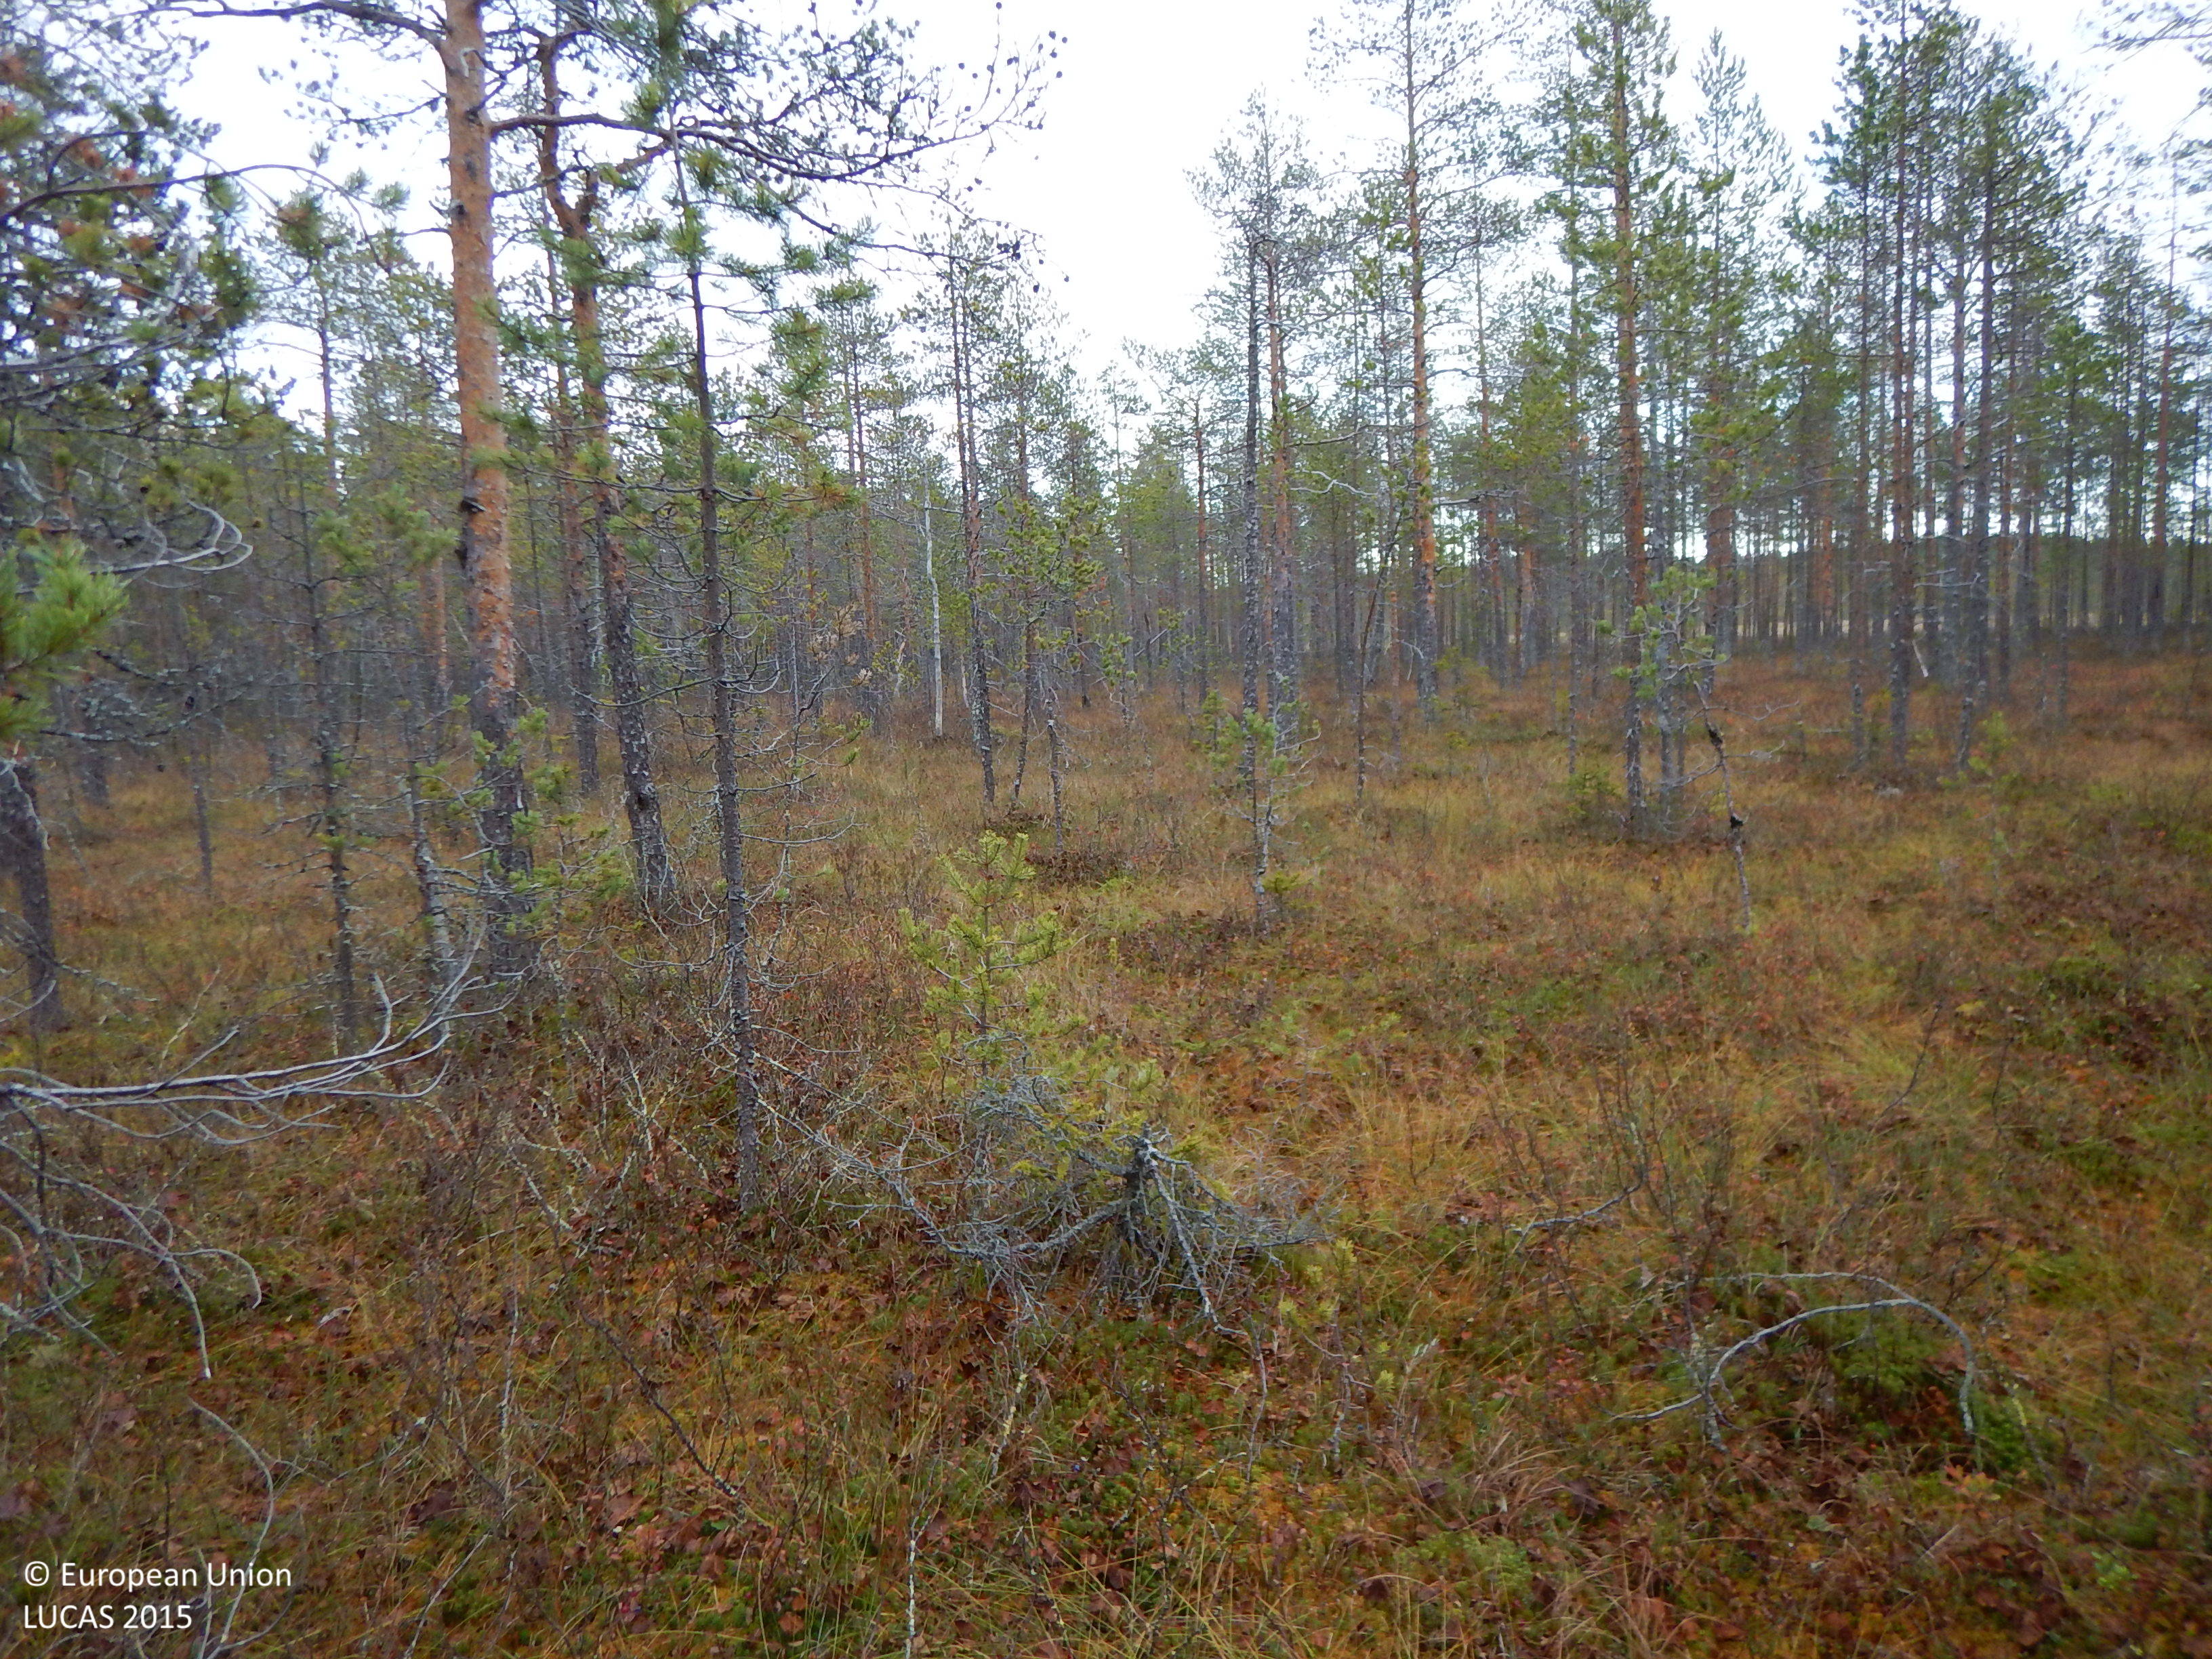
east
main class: Woodland
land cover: Pine dominated coniferous woodland
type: mire and swamp forests
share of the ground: 25 - 50 %
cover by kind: coniferous forest trees 40 %, lichens and mosses 30 %, shrubs 20 %, herbaceous plants 10 %
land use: Semi-natural and natural areas not in use
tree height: > 5 m
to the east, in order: Pine dominated coniferous woodland; Peatbogs; Pine dominated coniferous woodland
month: October
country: SE
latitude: 65.1010
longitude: 21.1515
